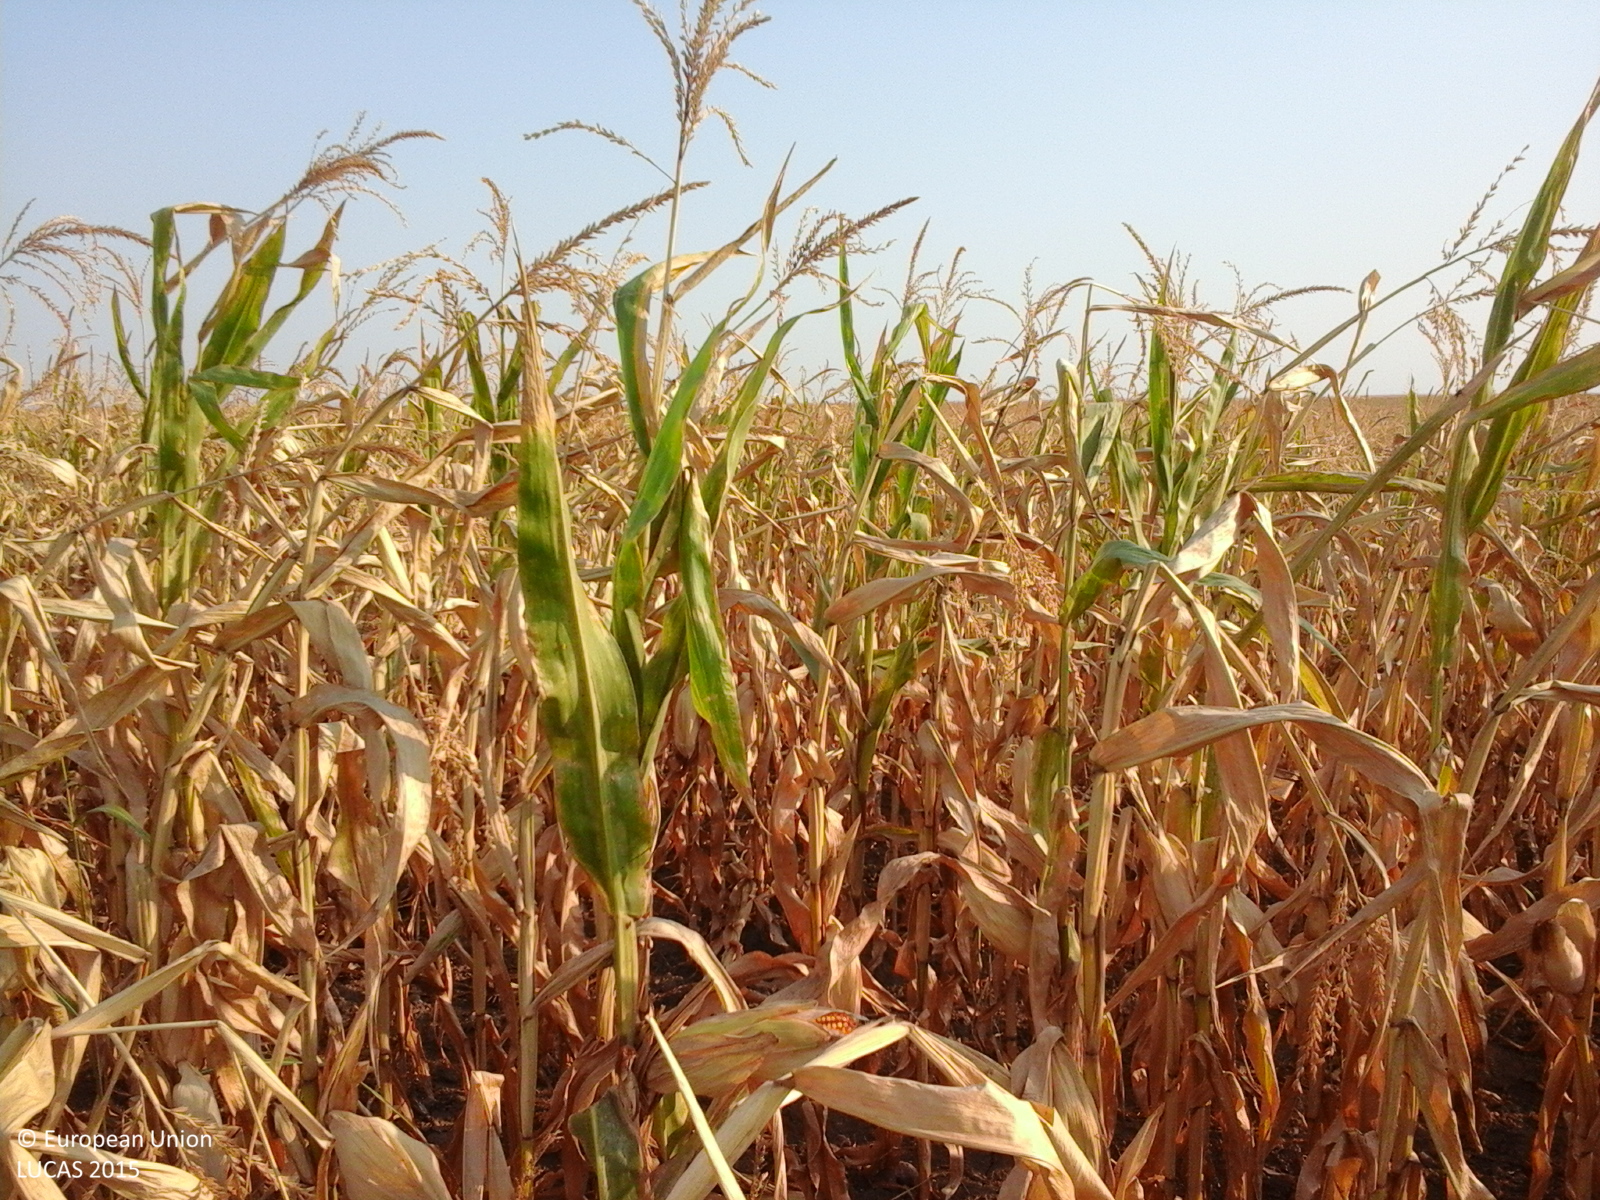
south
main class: Cropland
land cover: Maize
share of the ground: > 75 %
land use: Agriculture (excluding fallow land and kitchen gardens)
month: August
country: RO
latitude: 43.9992
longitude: 23.1757
